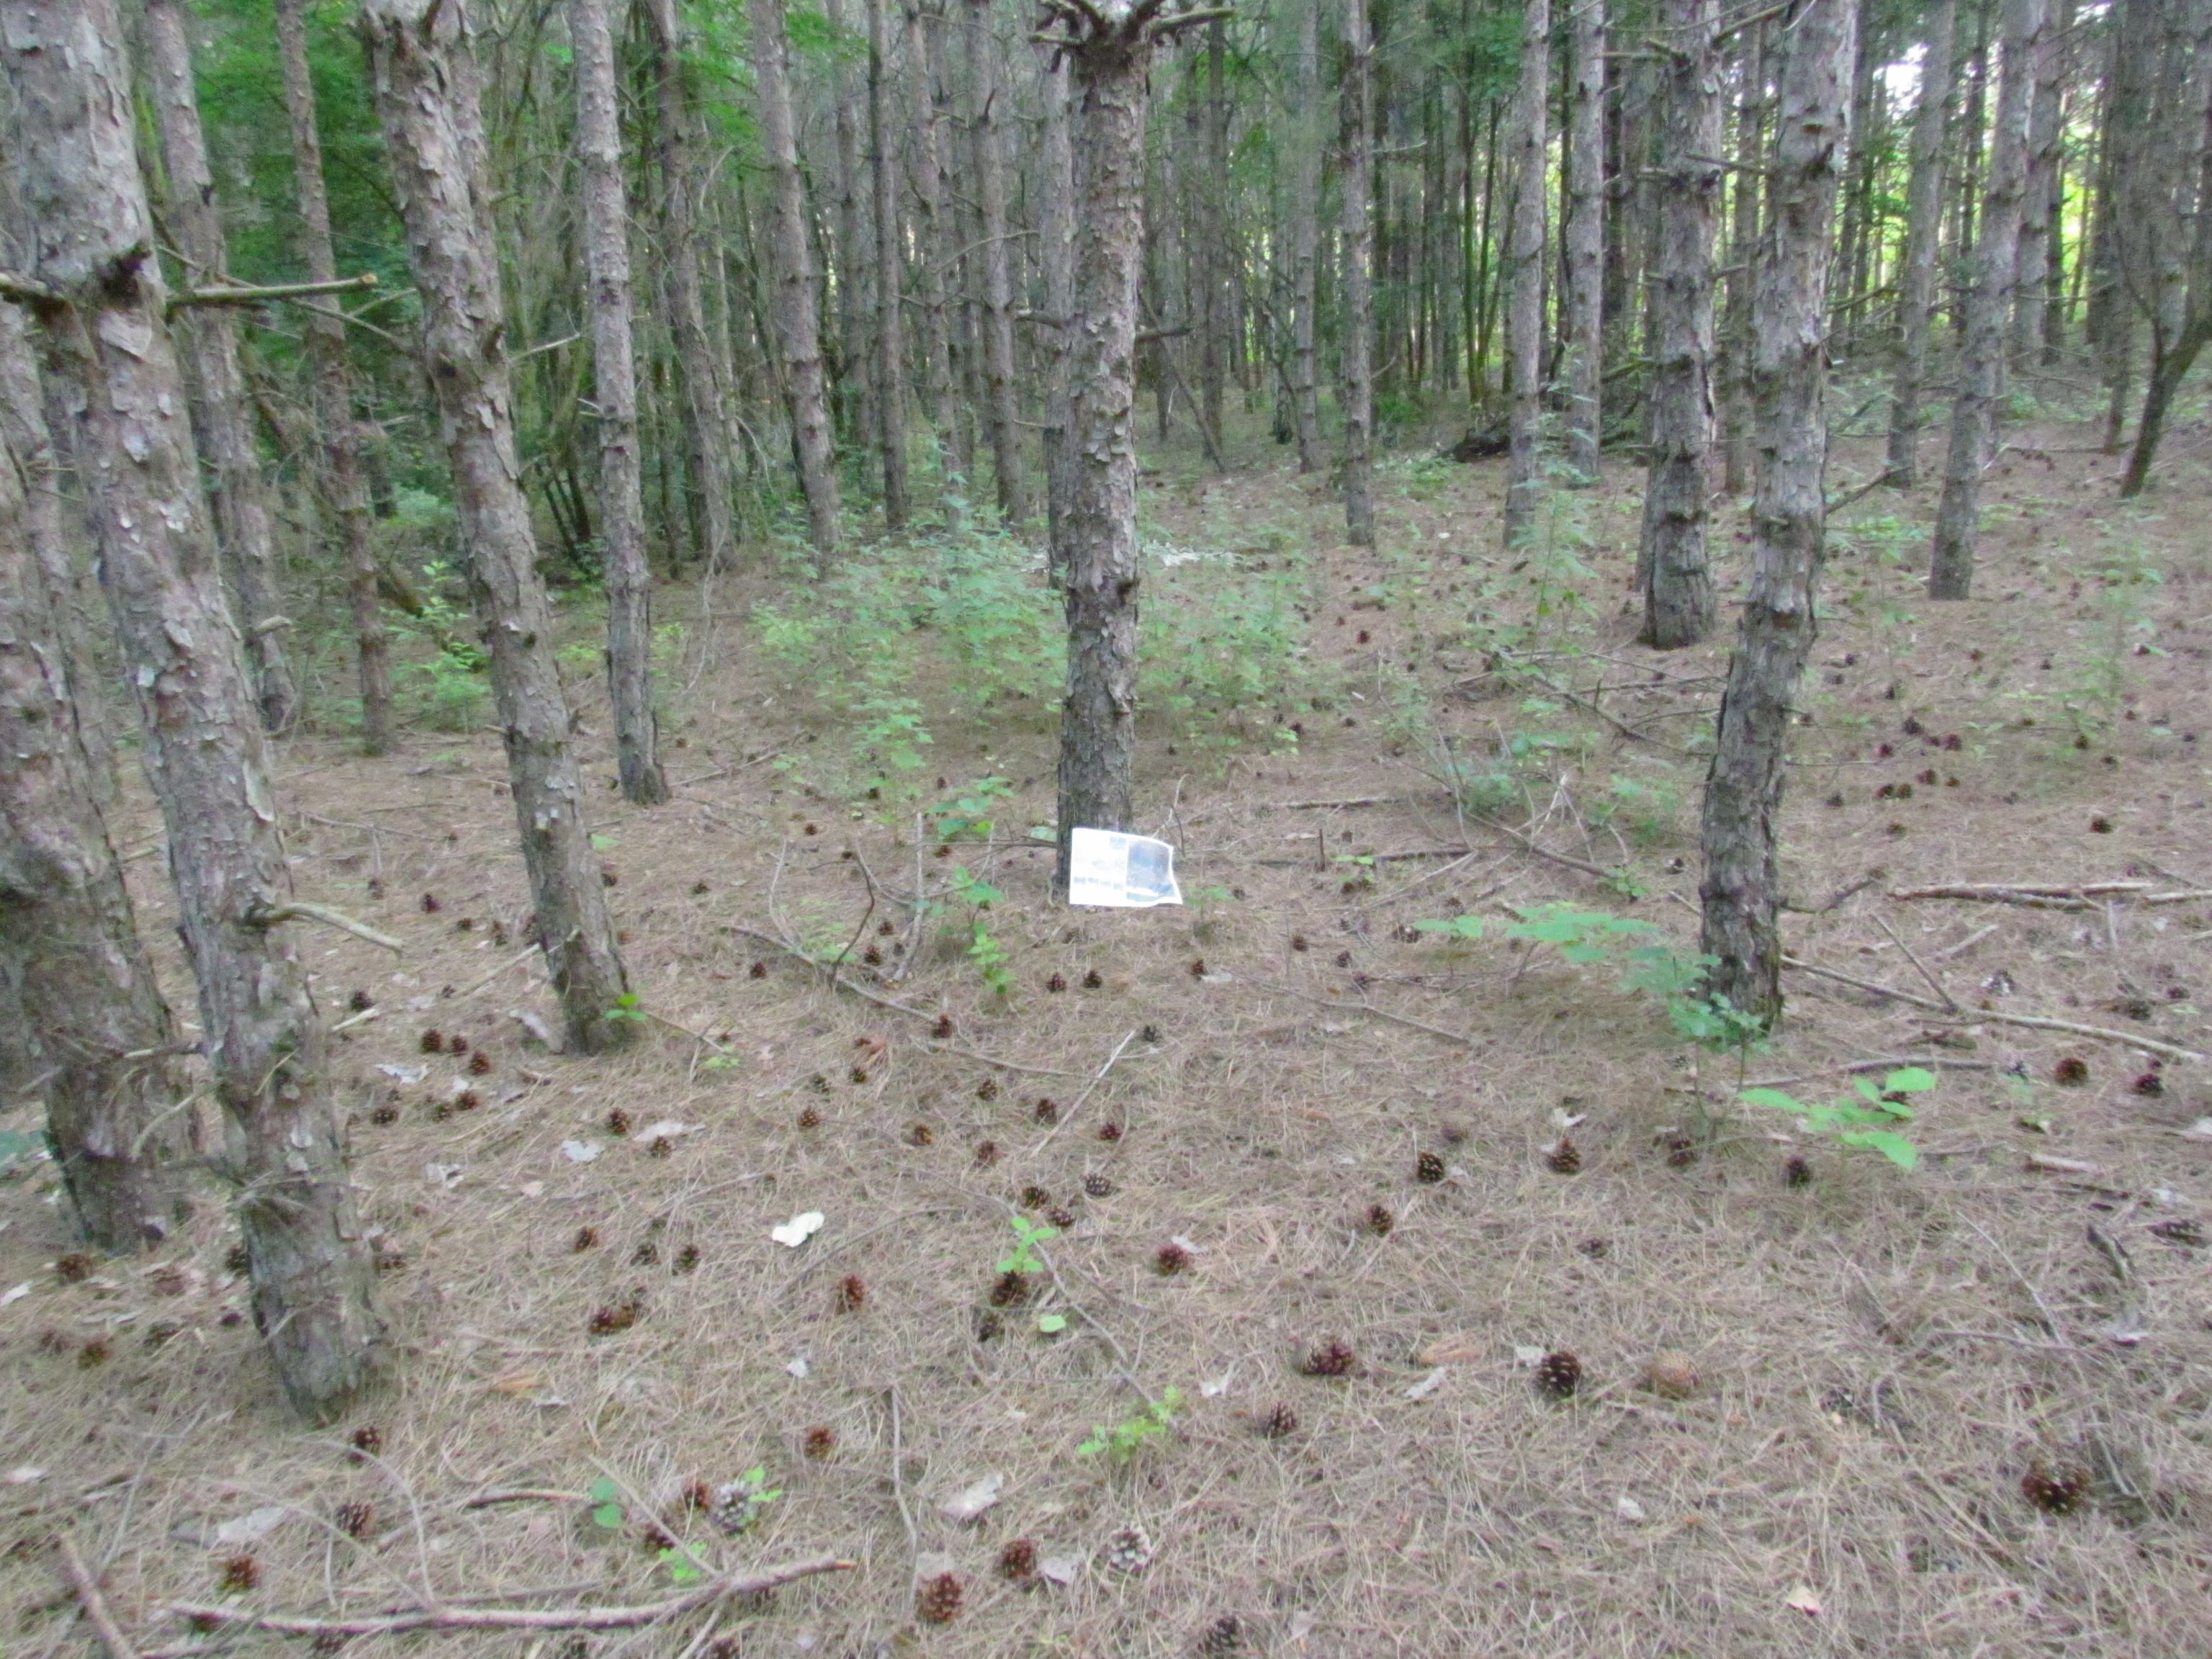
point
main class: Woodland
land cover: Pine dominated coniferous woodland
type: hemiboreal forest and nemoral coniferous forest and mixed broadleaved-coniferous forest
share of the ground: > 75 %
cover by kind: coniferous forest trees 100 %
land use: Forestry
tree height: > 5 m
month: June
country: BG
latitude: 42.6229
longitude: 27.3181
